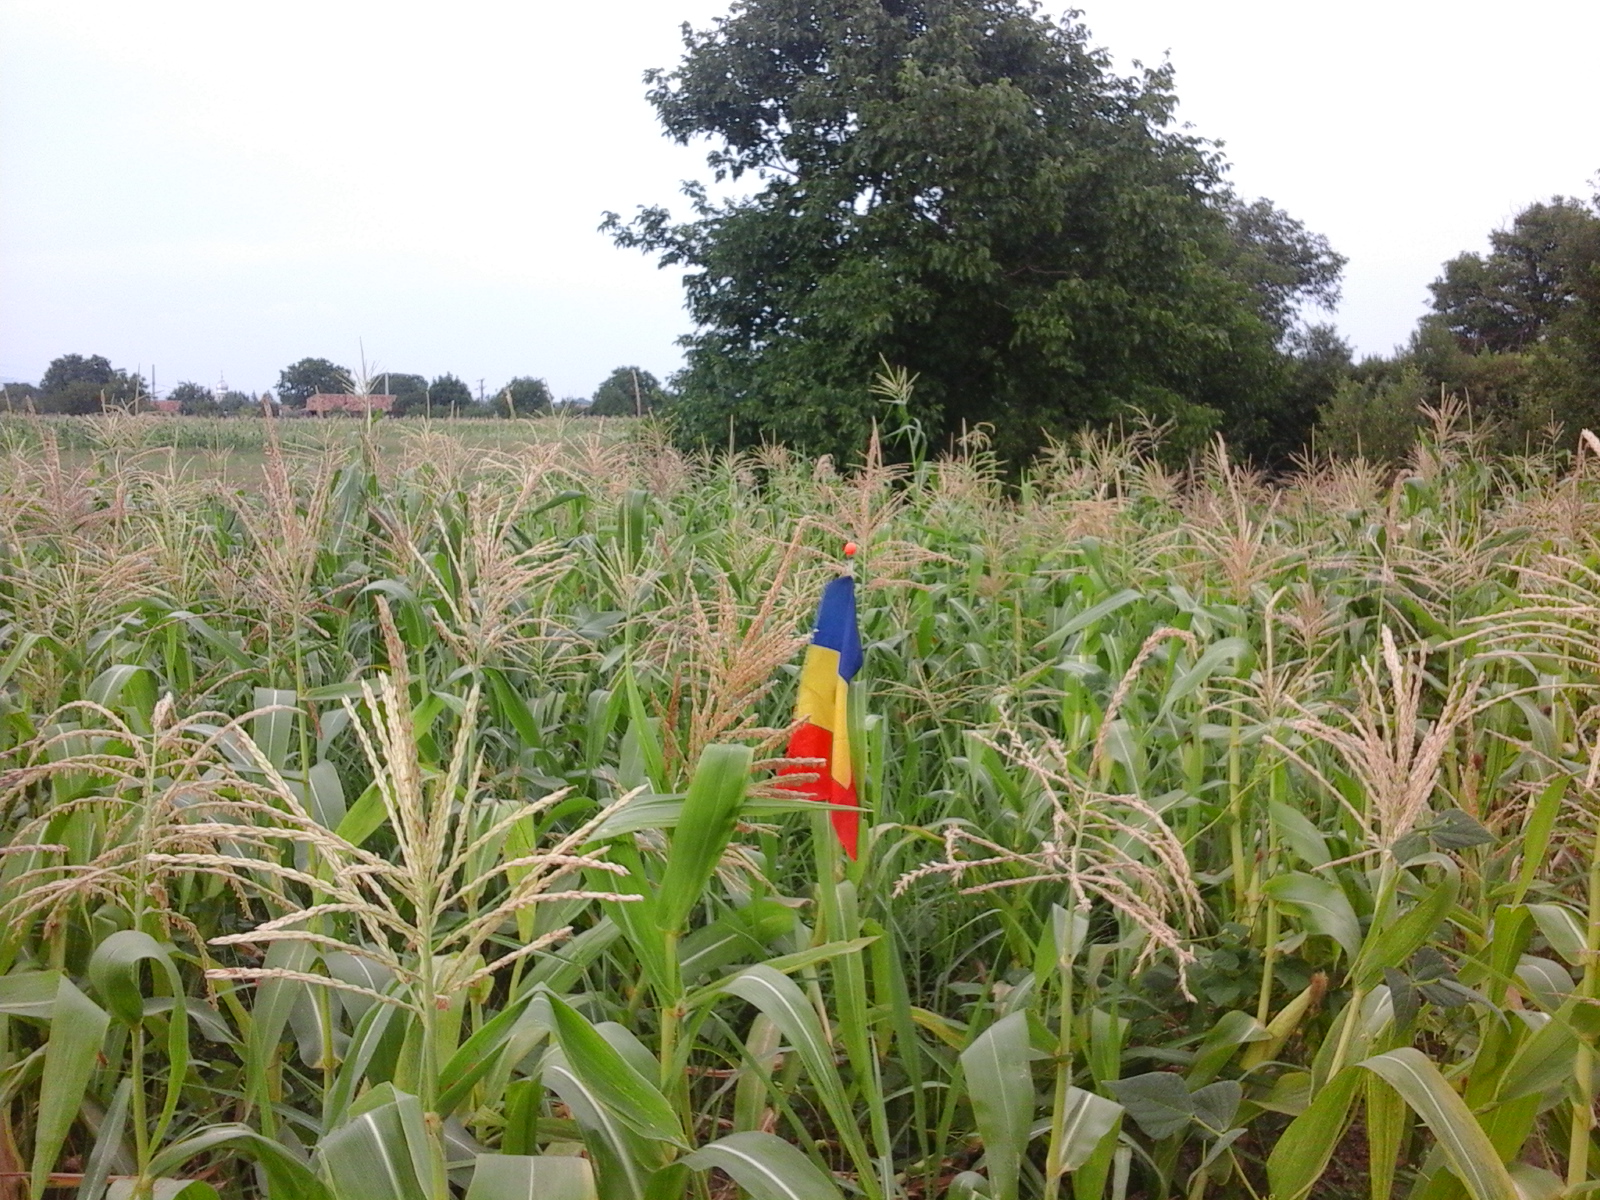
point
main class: Cropland
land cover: Maize
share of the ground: > 75 %
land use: Agriculture (excluding fallow land and kitchen gardens)
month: July
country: RO
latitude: 46.1966
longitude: 26.7378
